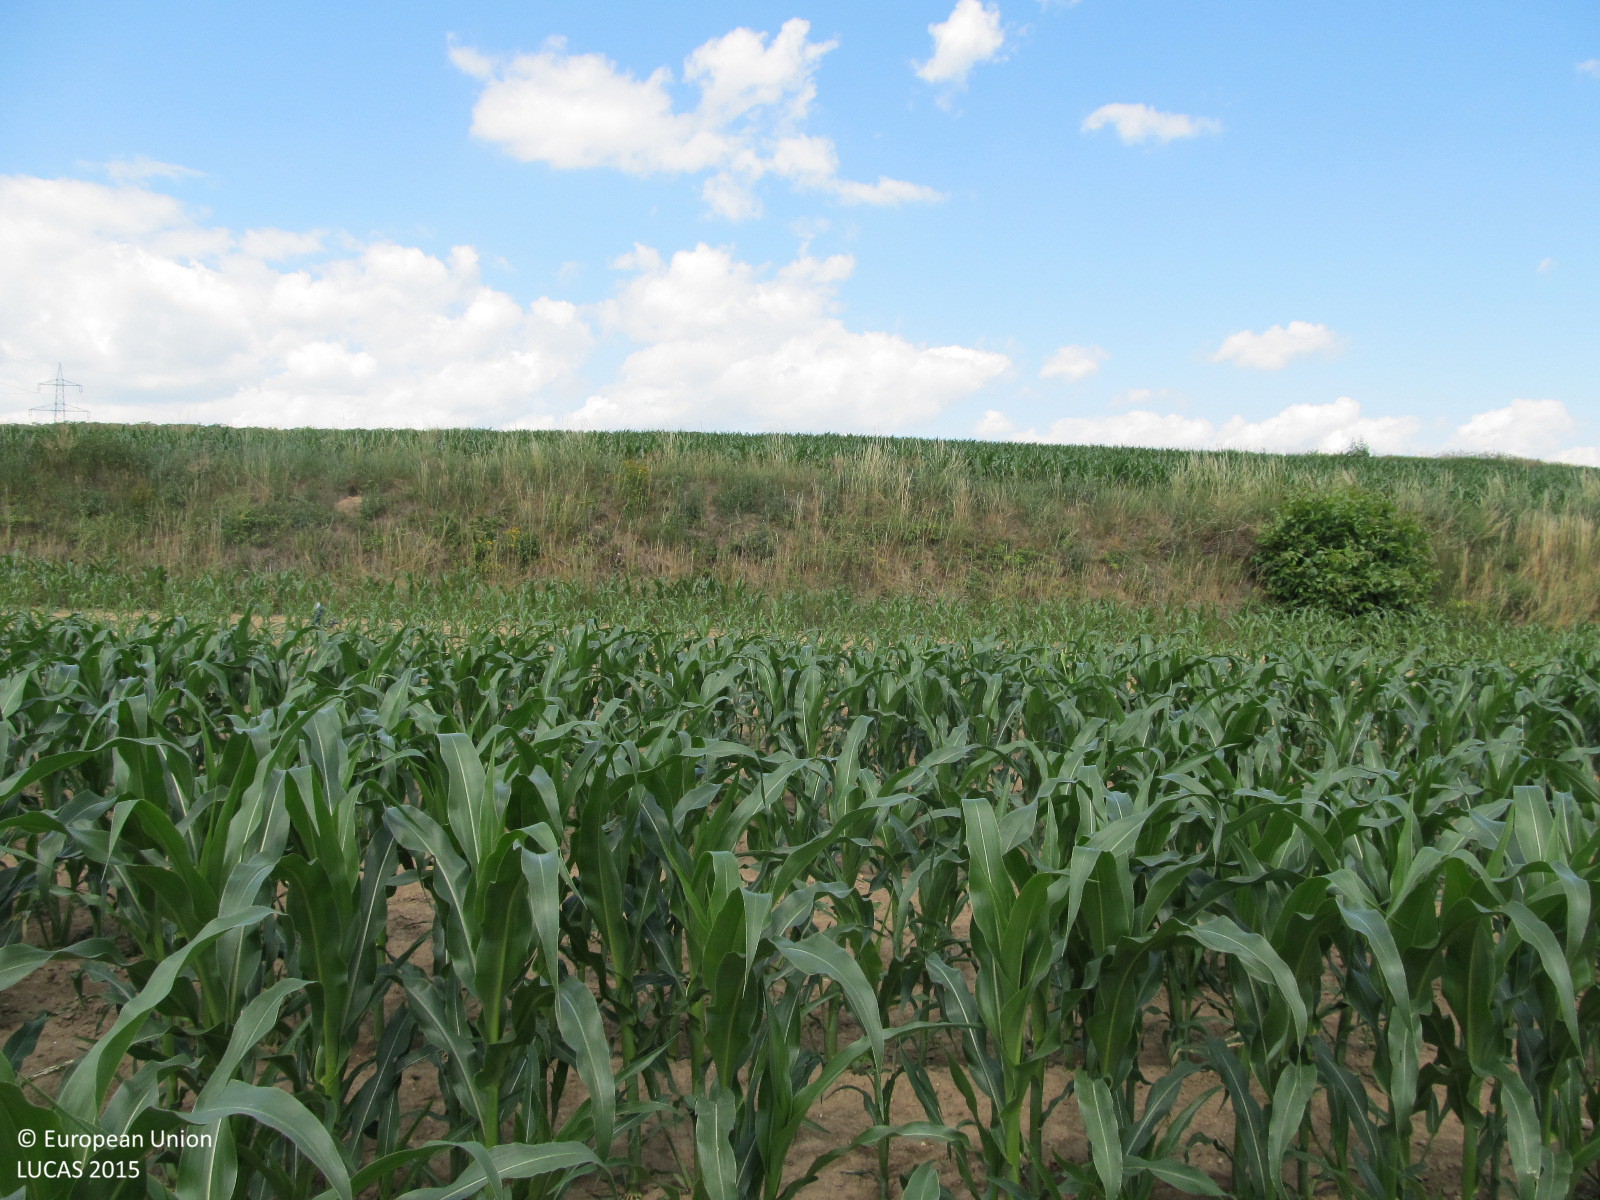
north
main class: Cropland
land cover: Maize
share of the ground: 50 - 75 %
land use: Agriculture (excluding fallow land and kitchen gardens)
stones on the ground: < 10 %
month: June
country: AT
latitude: 48.5184
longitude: 15.8660
